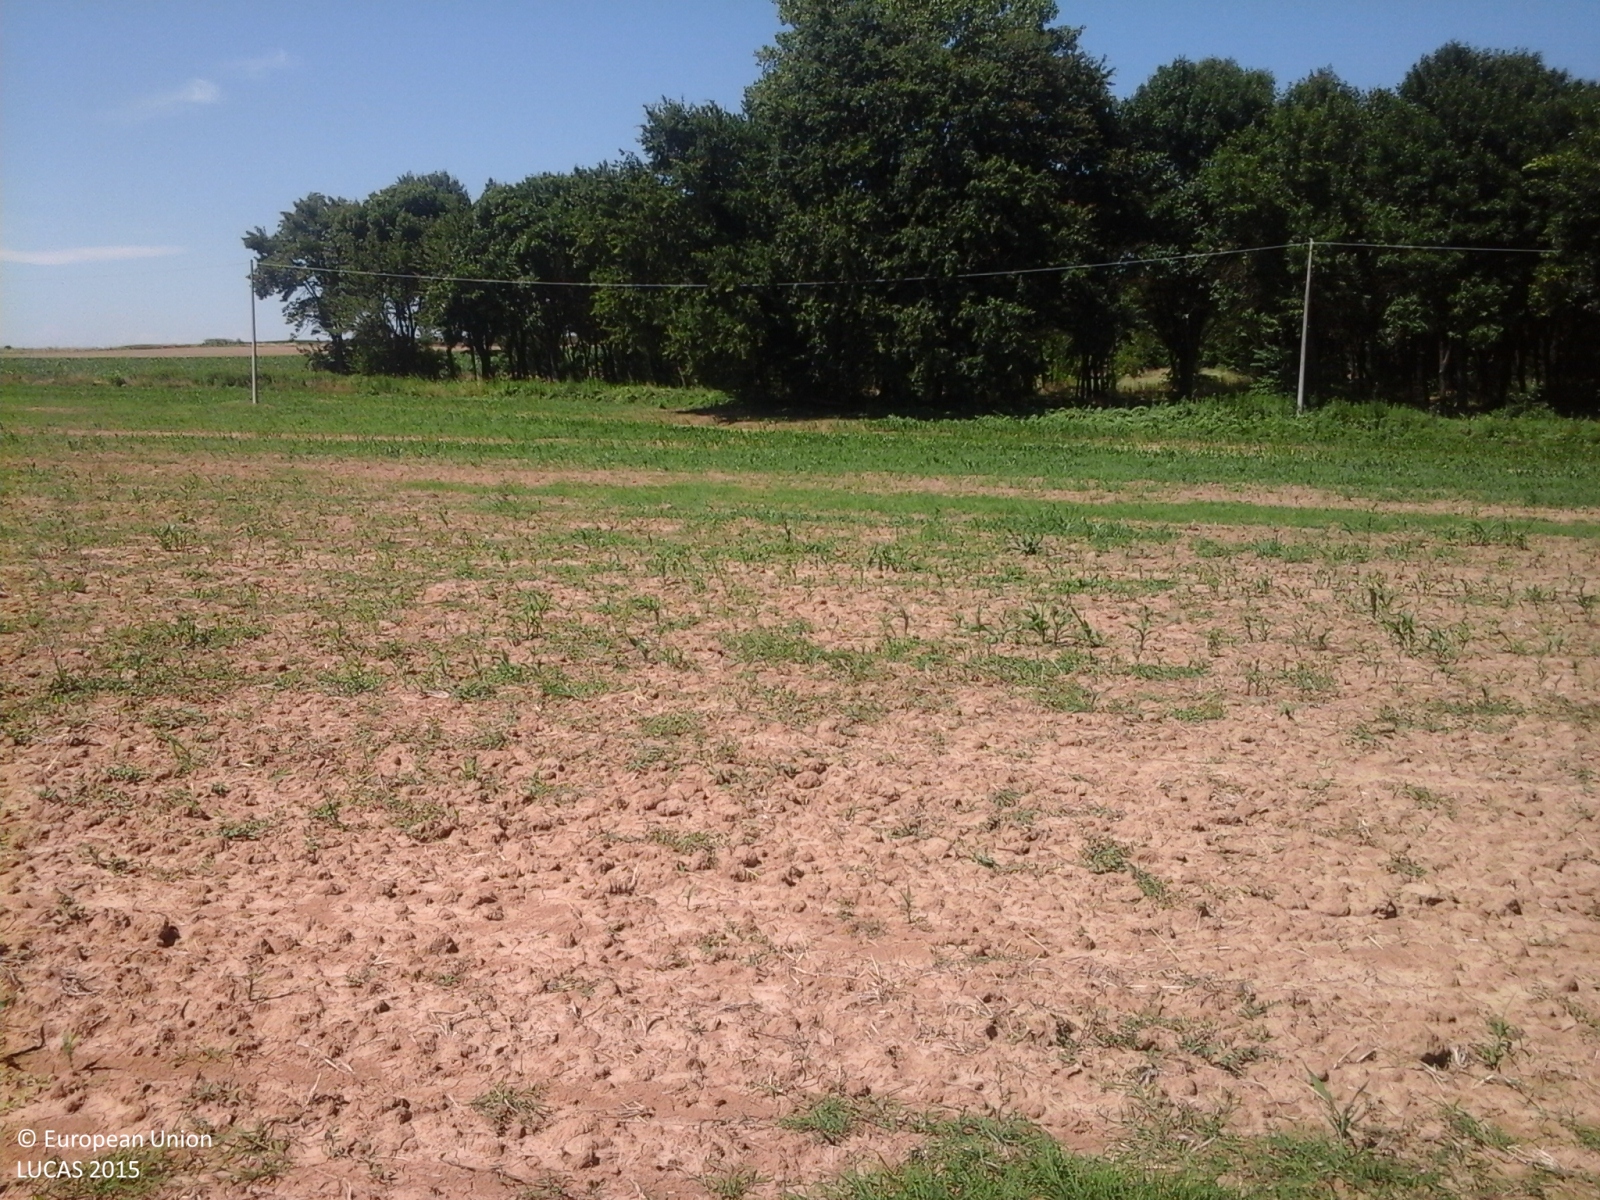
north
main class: Grassland
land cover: Grassland without tree/shrub cover
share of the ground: 50 - 75 %
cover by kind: herbaceous plants 65 %, unconsolidated bare surface 35 %
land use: Agriculture (excluding fallow land and kitchen gardens)
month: June
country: IT
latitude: 45.0444
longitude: 8.5934
